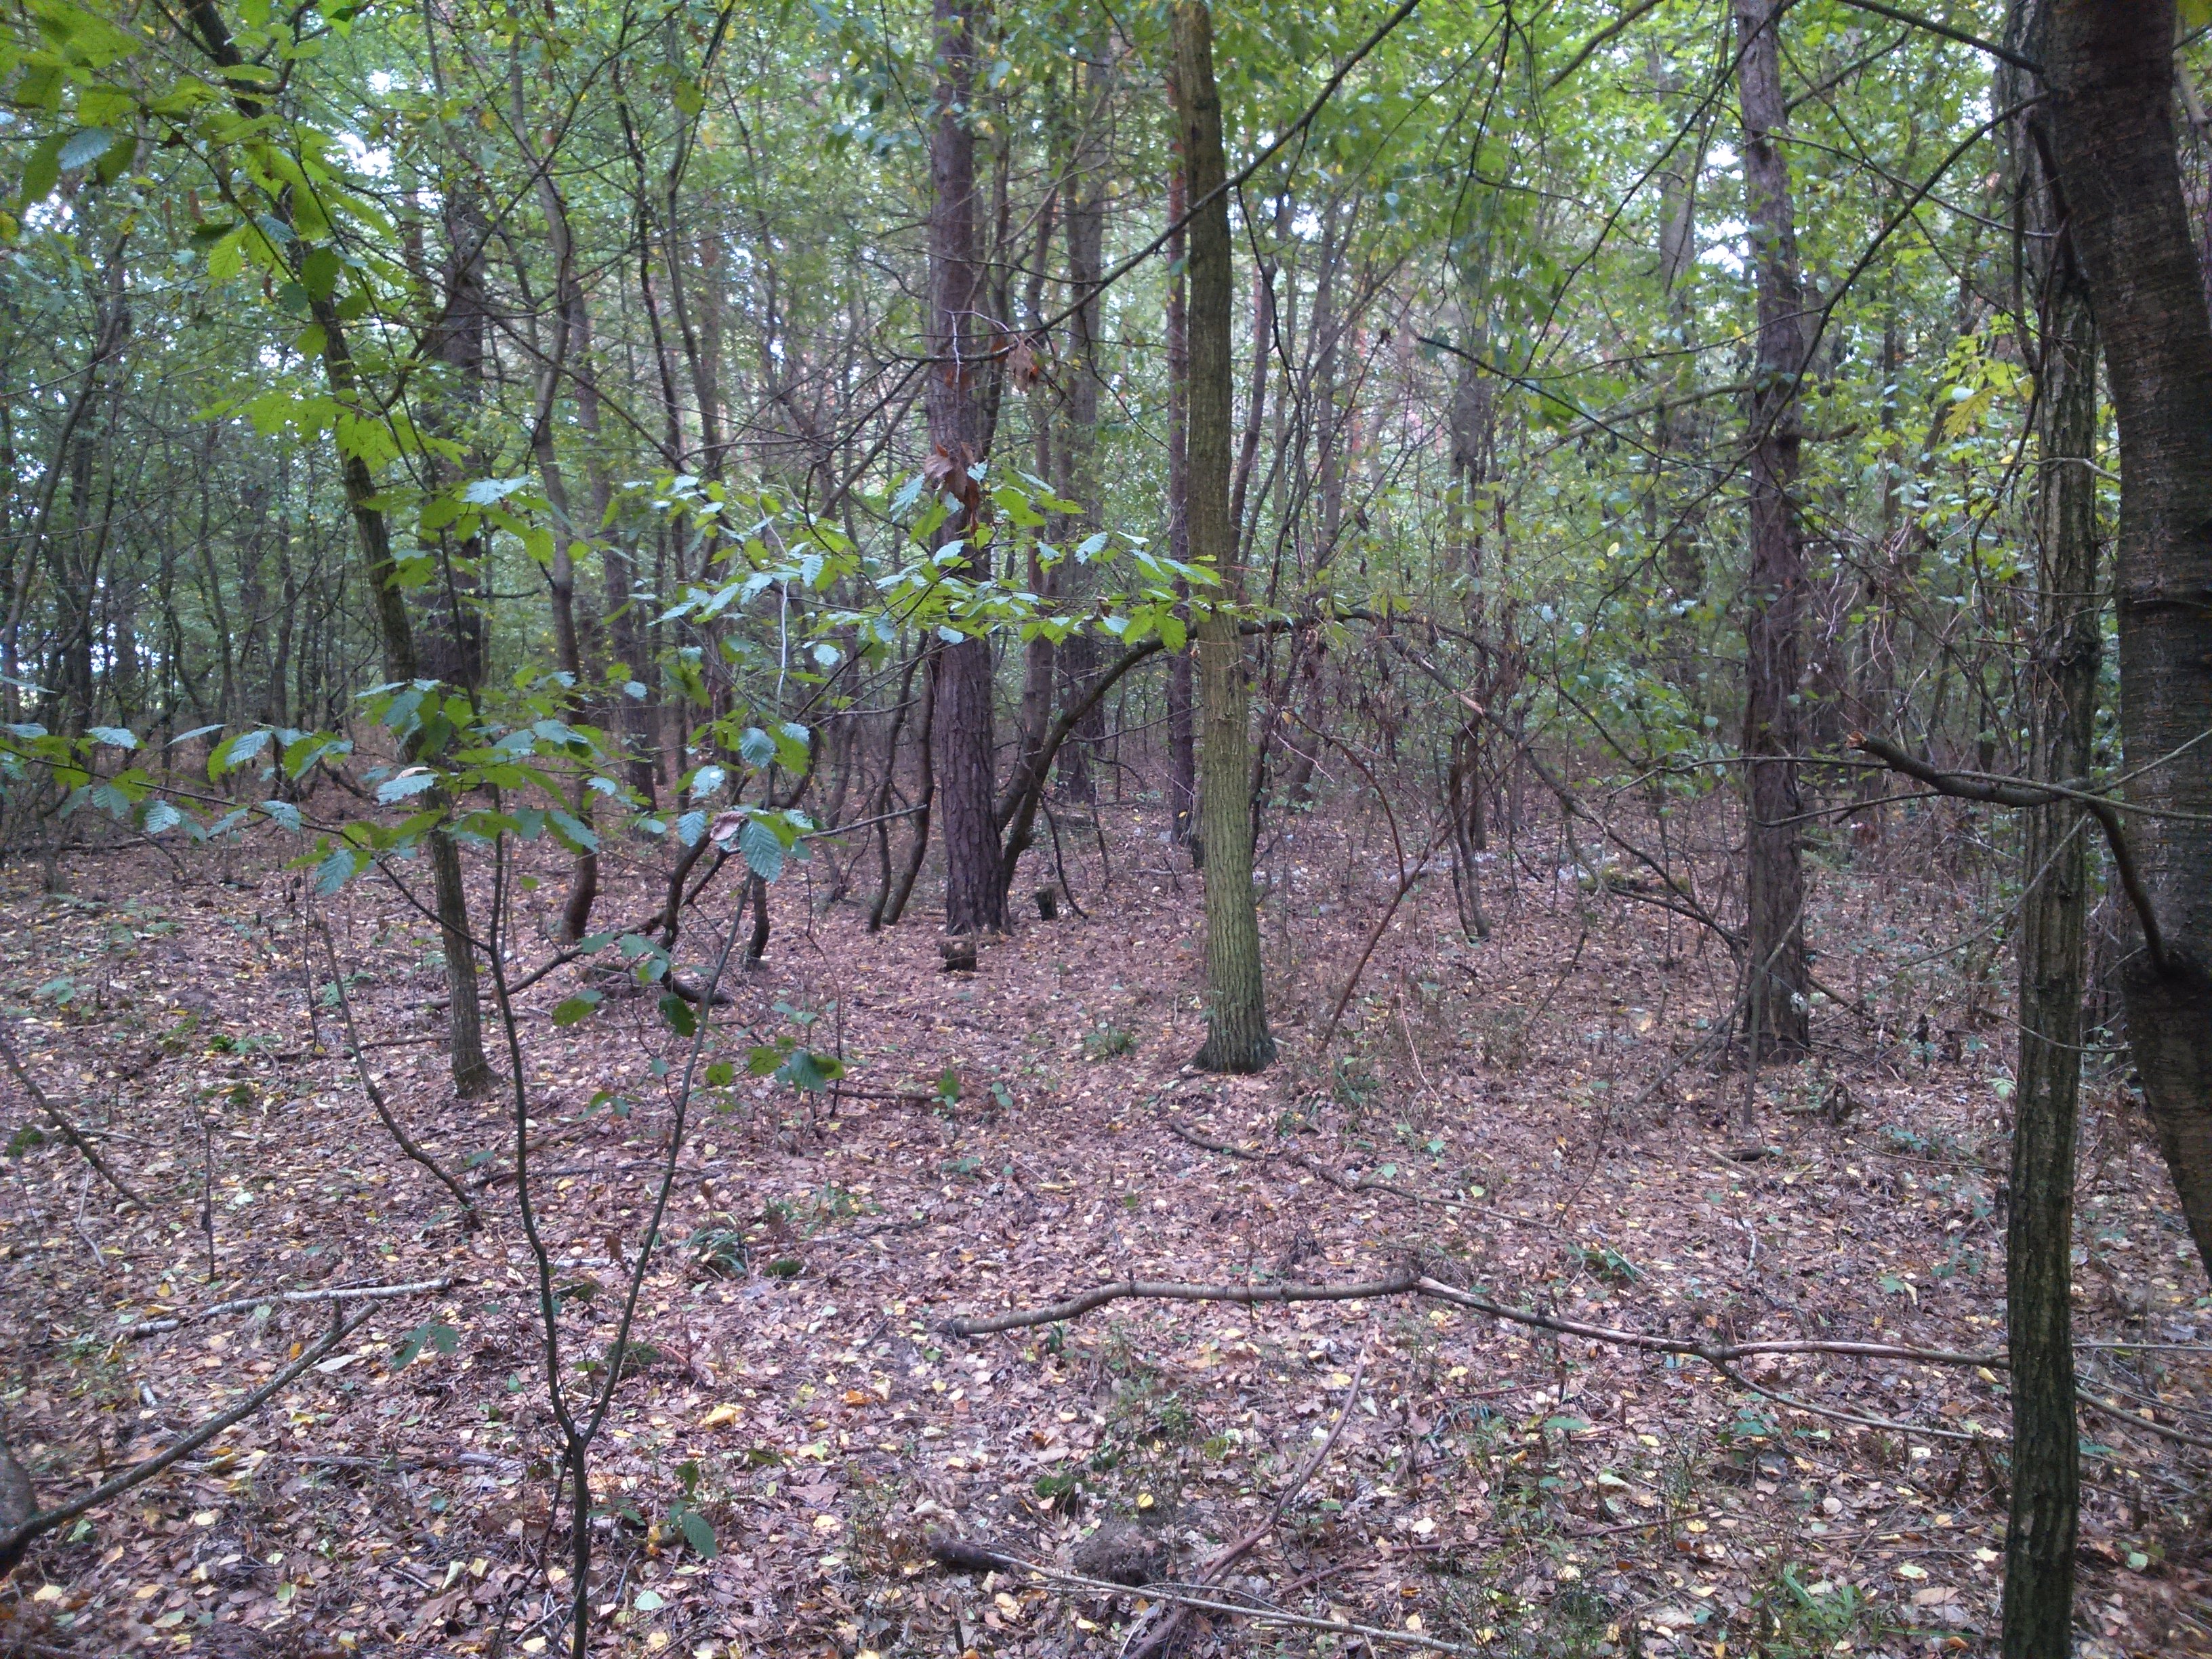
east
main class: Woodland
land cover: Other mixed woodland
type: hemiboreal forest and nemoral coniferous forest and mixed broadleaved-coniferous forest
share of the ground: > 75 %
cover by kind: broadleaved forest trees 55 %, coniferous forest trees 35 %, shrubs 10 %
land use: Forestry
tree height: > 5 m
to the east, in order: Other mixed woodland; Tracks; Other mixed woodland; Broadleaved woodland; Other bare soil
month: September
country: PL
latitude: 52.2571
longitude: 22.1767
